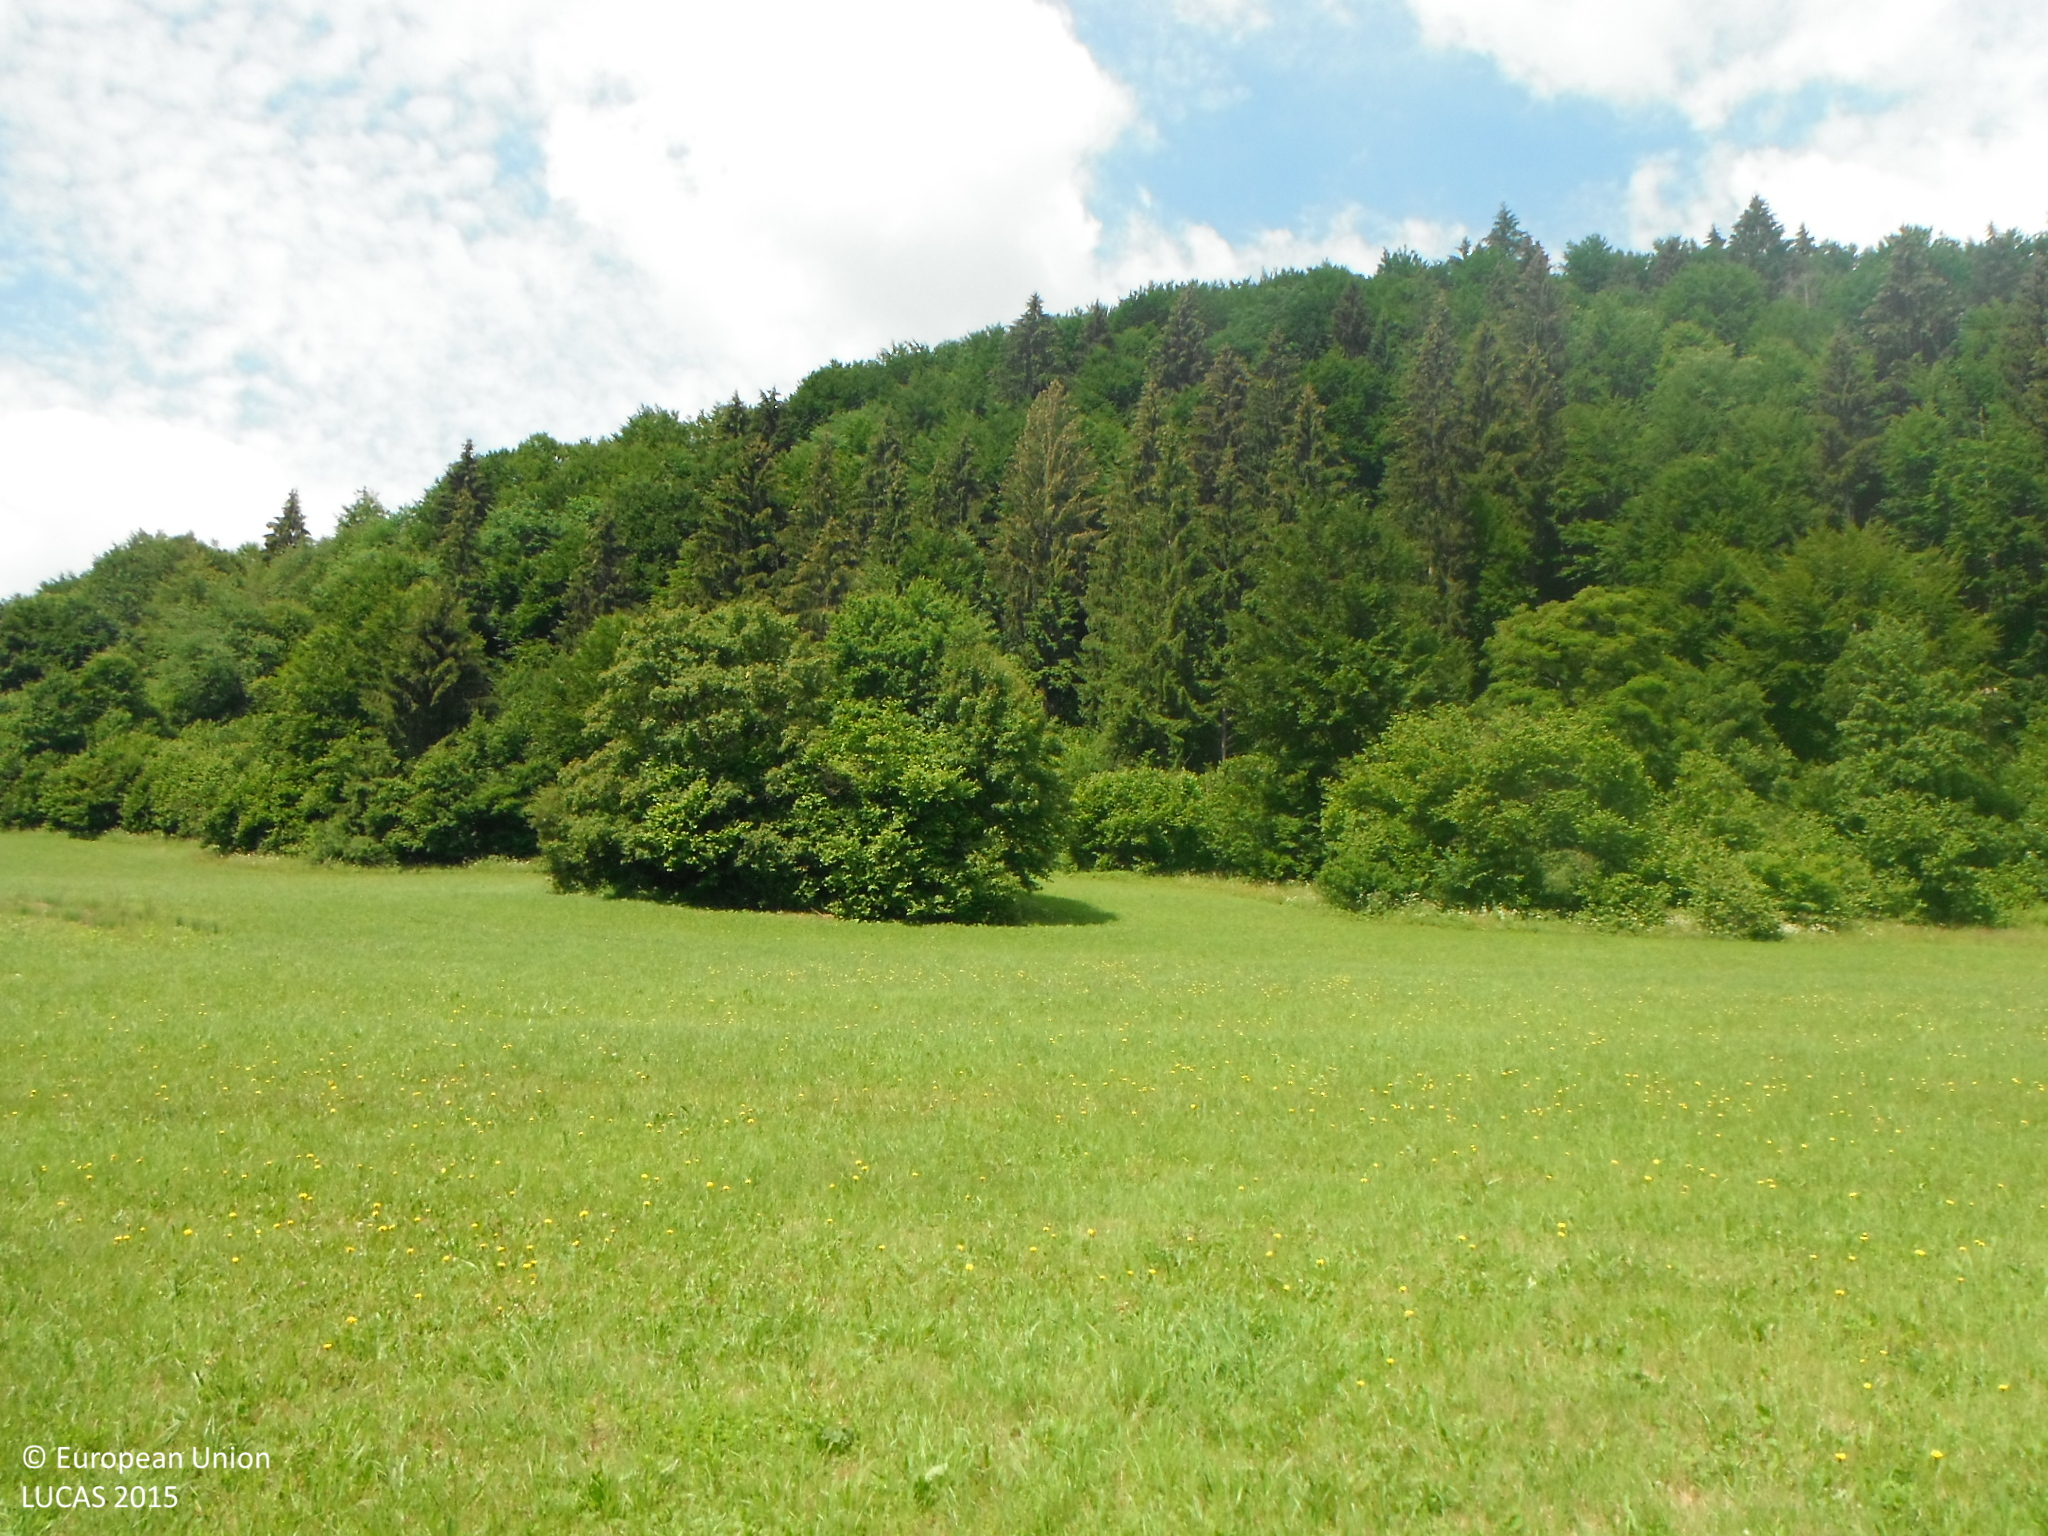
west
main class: Grassland
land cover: Grassland without tree/shrub cover
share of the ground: > 75 %
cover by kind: herbaceous plants 100 %
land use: Agriculture (excluding fallow land and kitchen gardens)
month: June
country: SK
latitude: 49.2845
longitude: 19.4429
